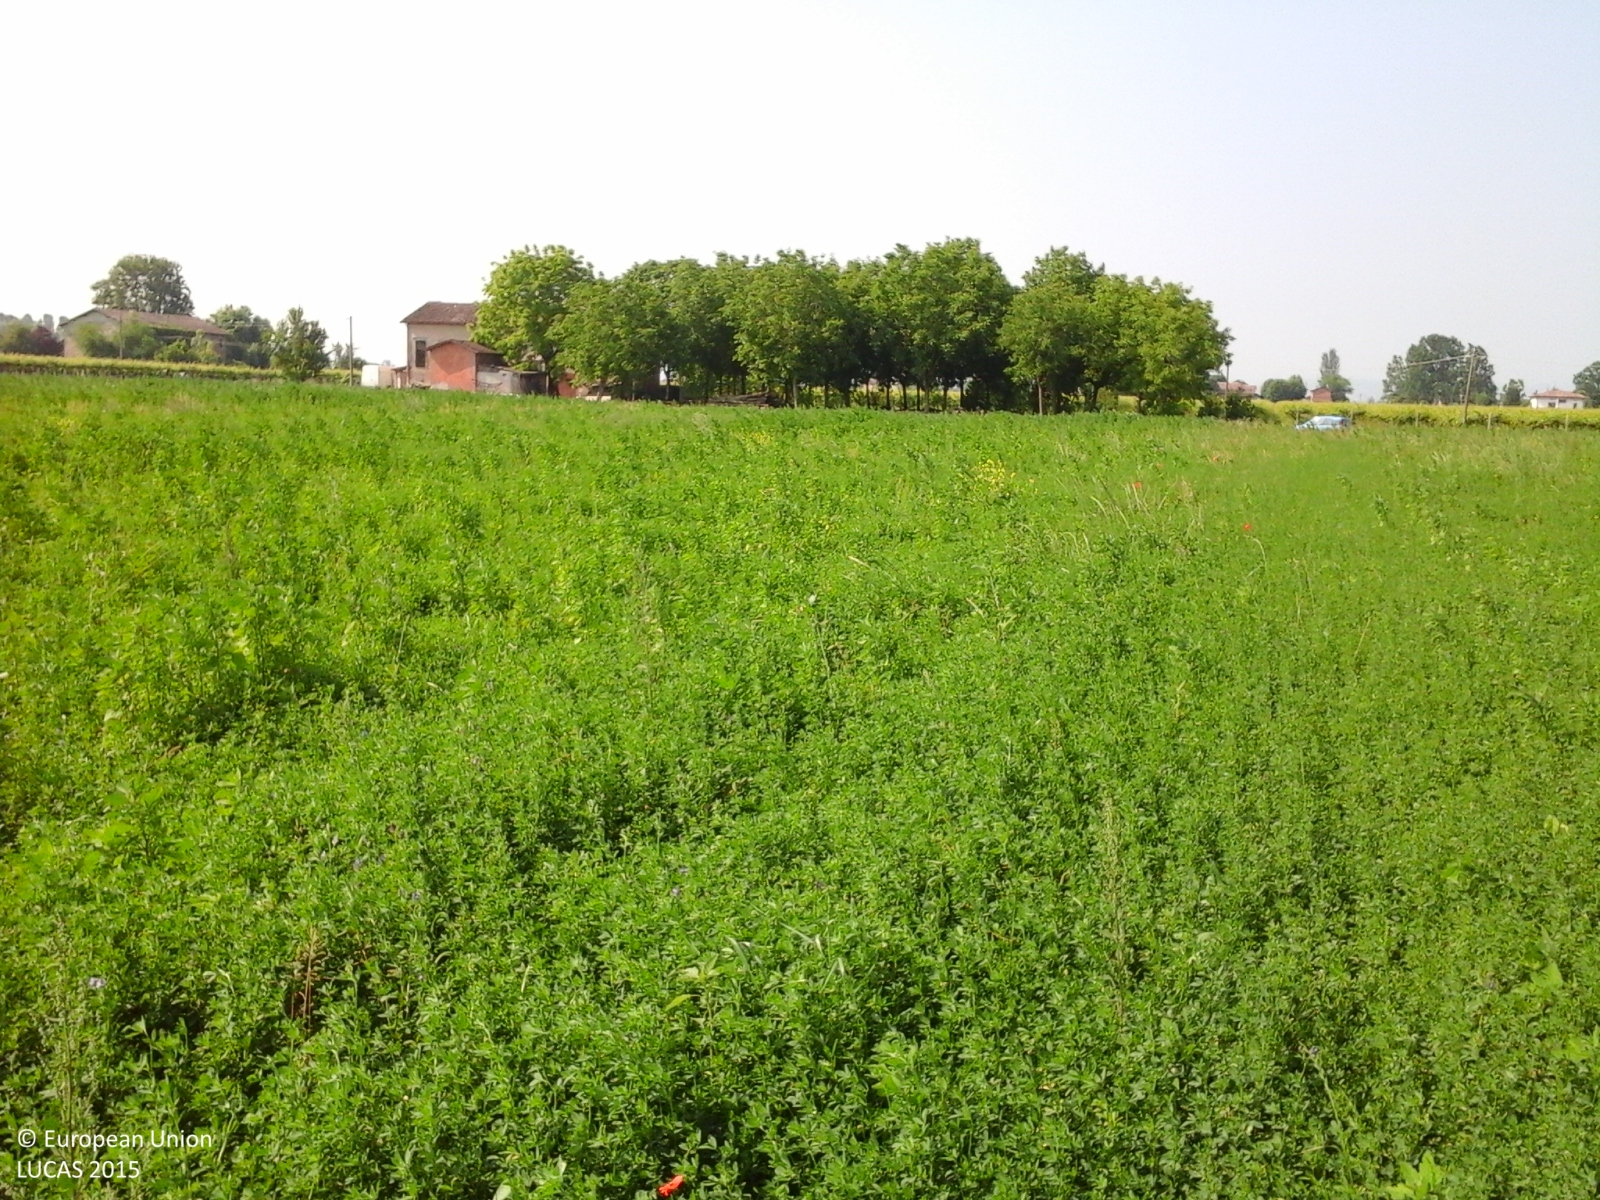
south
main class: Cropland
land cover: Lucerne
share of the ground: > 75 %
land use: Agriculture (excluding fallow land and kitchen gardens)
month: May
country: IT
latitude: 44.7082
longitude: 10.7935
